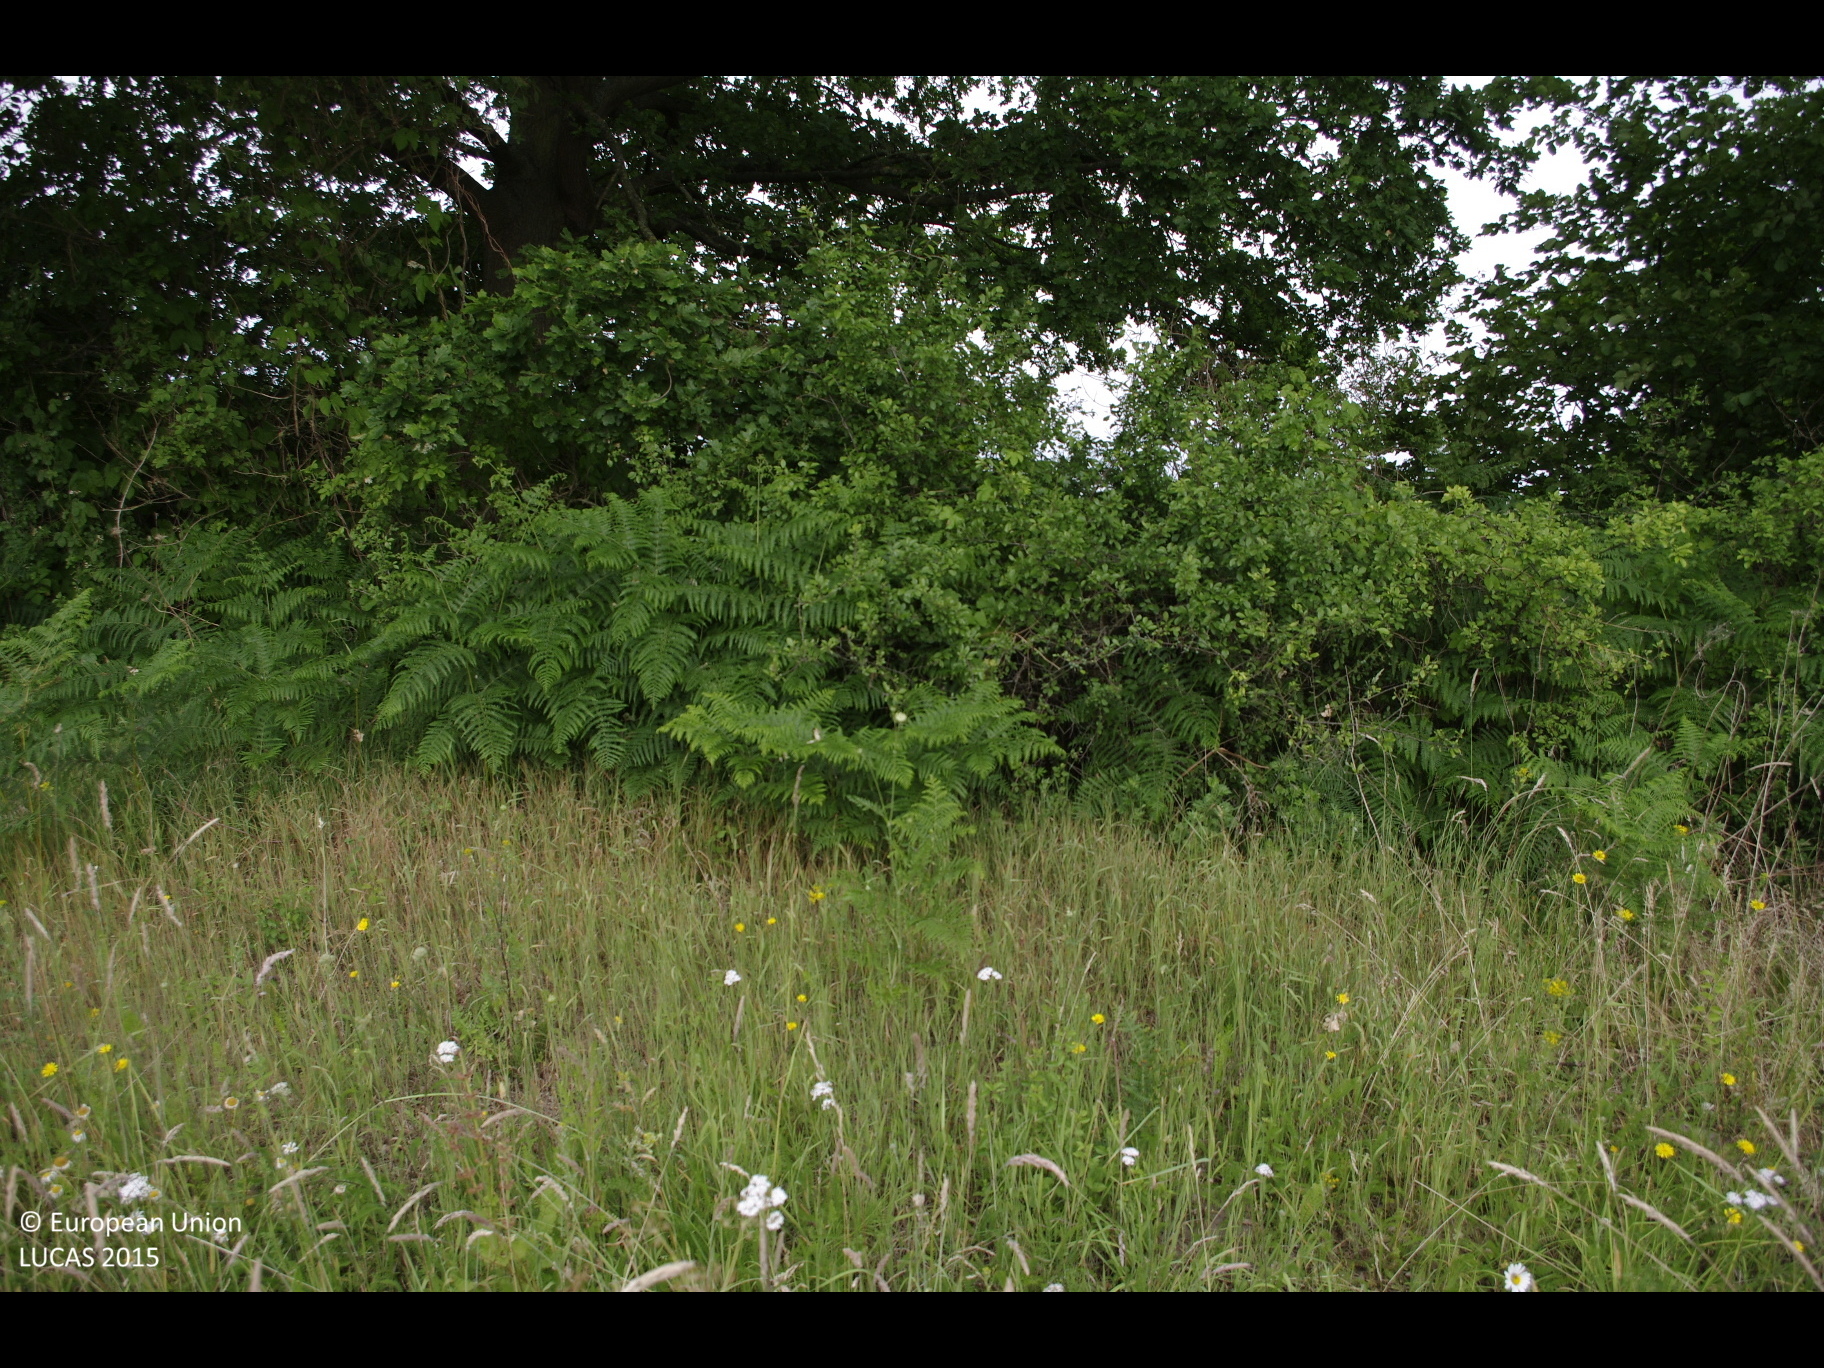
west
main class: Grassland
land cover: Grassland without tree/shrub cover
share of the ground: > 75 %
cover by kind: herbaceous plants 100 %
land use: Agriculture (excluding fallow land and kitchen gardens)
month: July
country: DE
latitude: 53.8317
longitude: 10.6226
